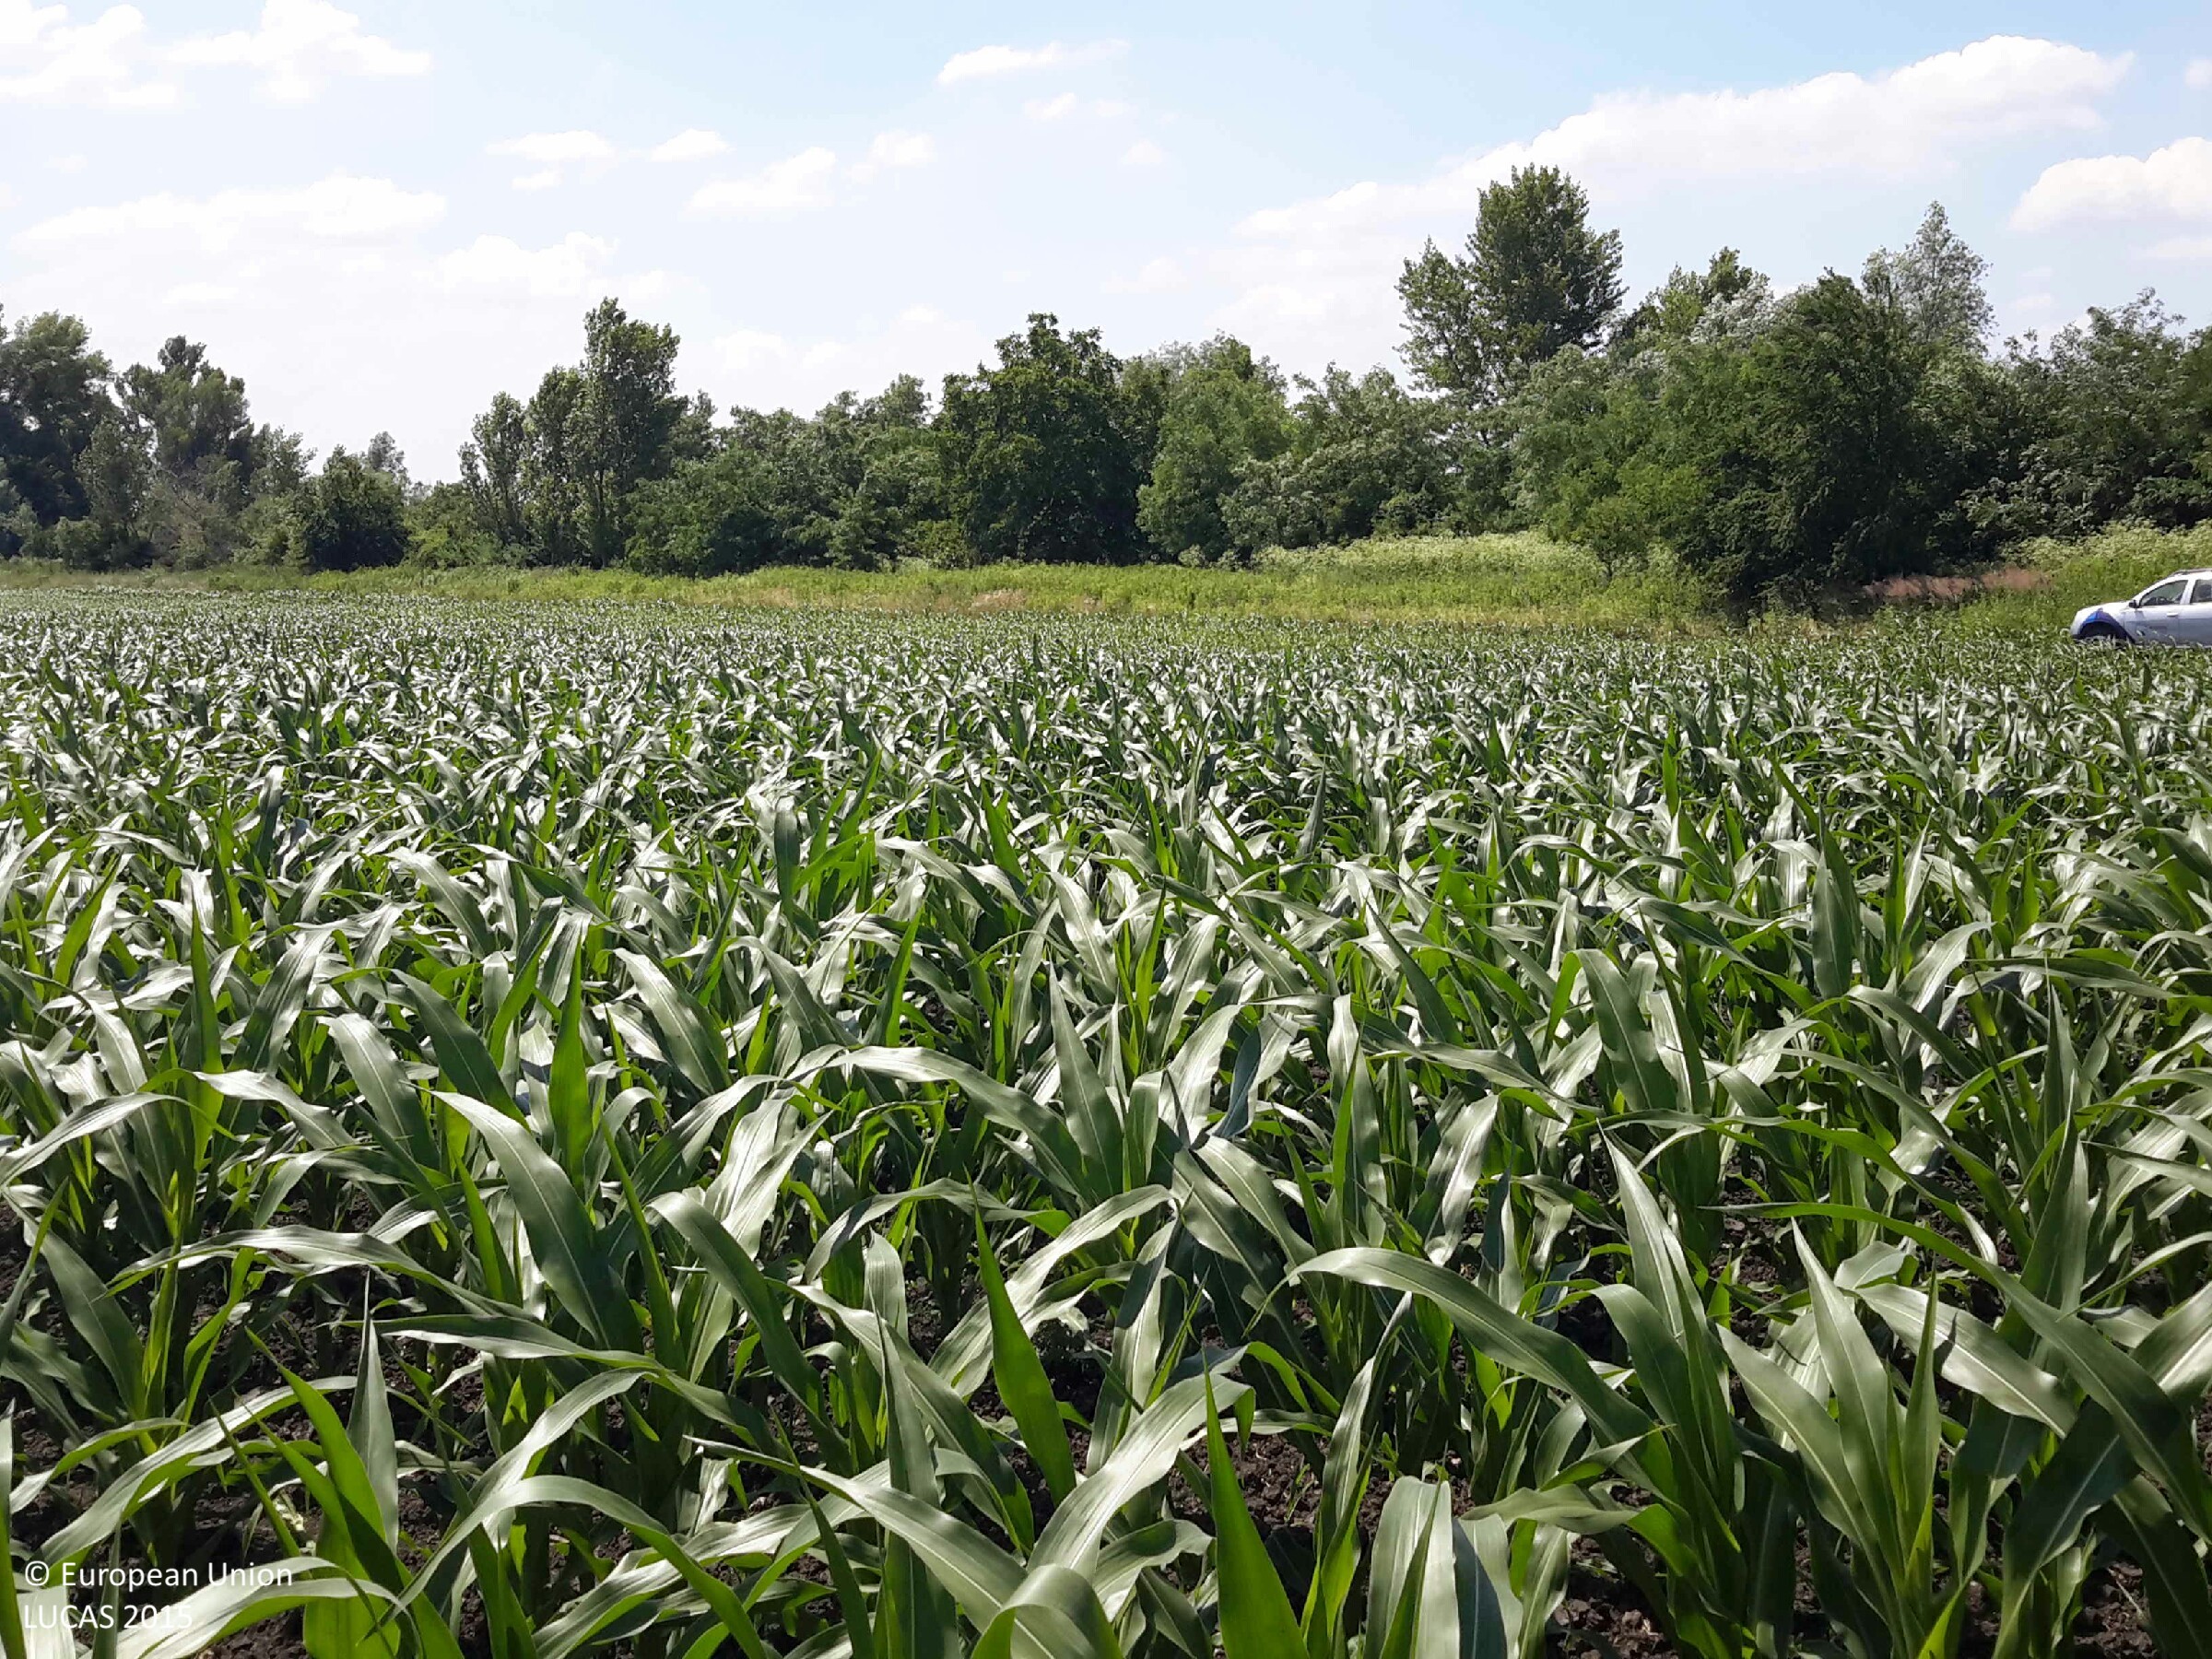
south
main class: Cropland
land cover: Maize
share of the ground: > 75 %
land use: Agriculture (excluding fallow land and kitchen gardens)
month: June
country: HU
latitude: 47.6836
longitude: 17.4283
